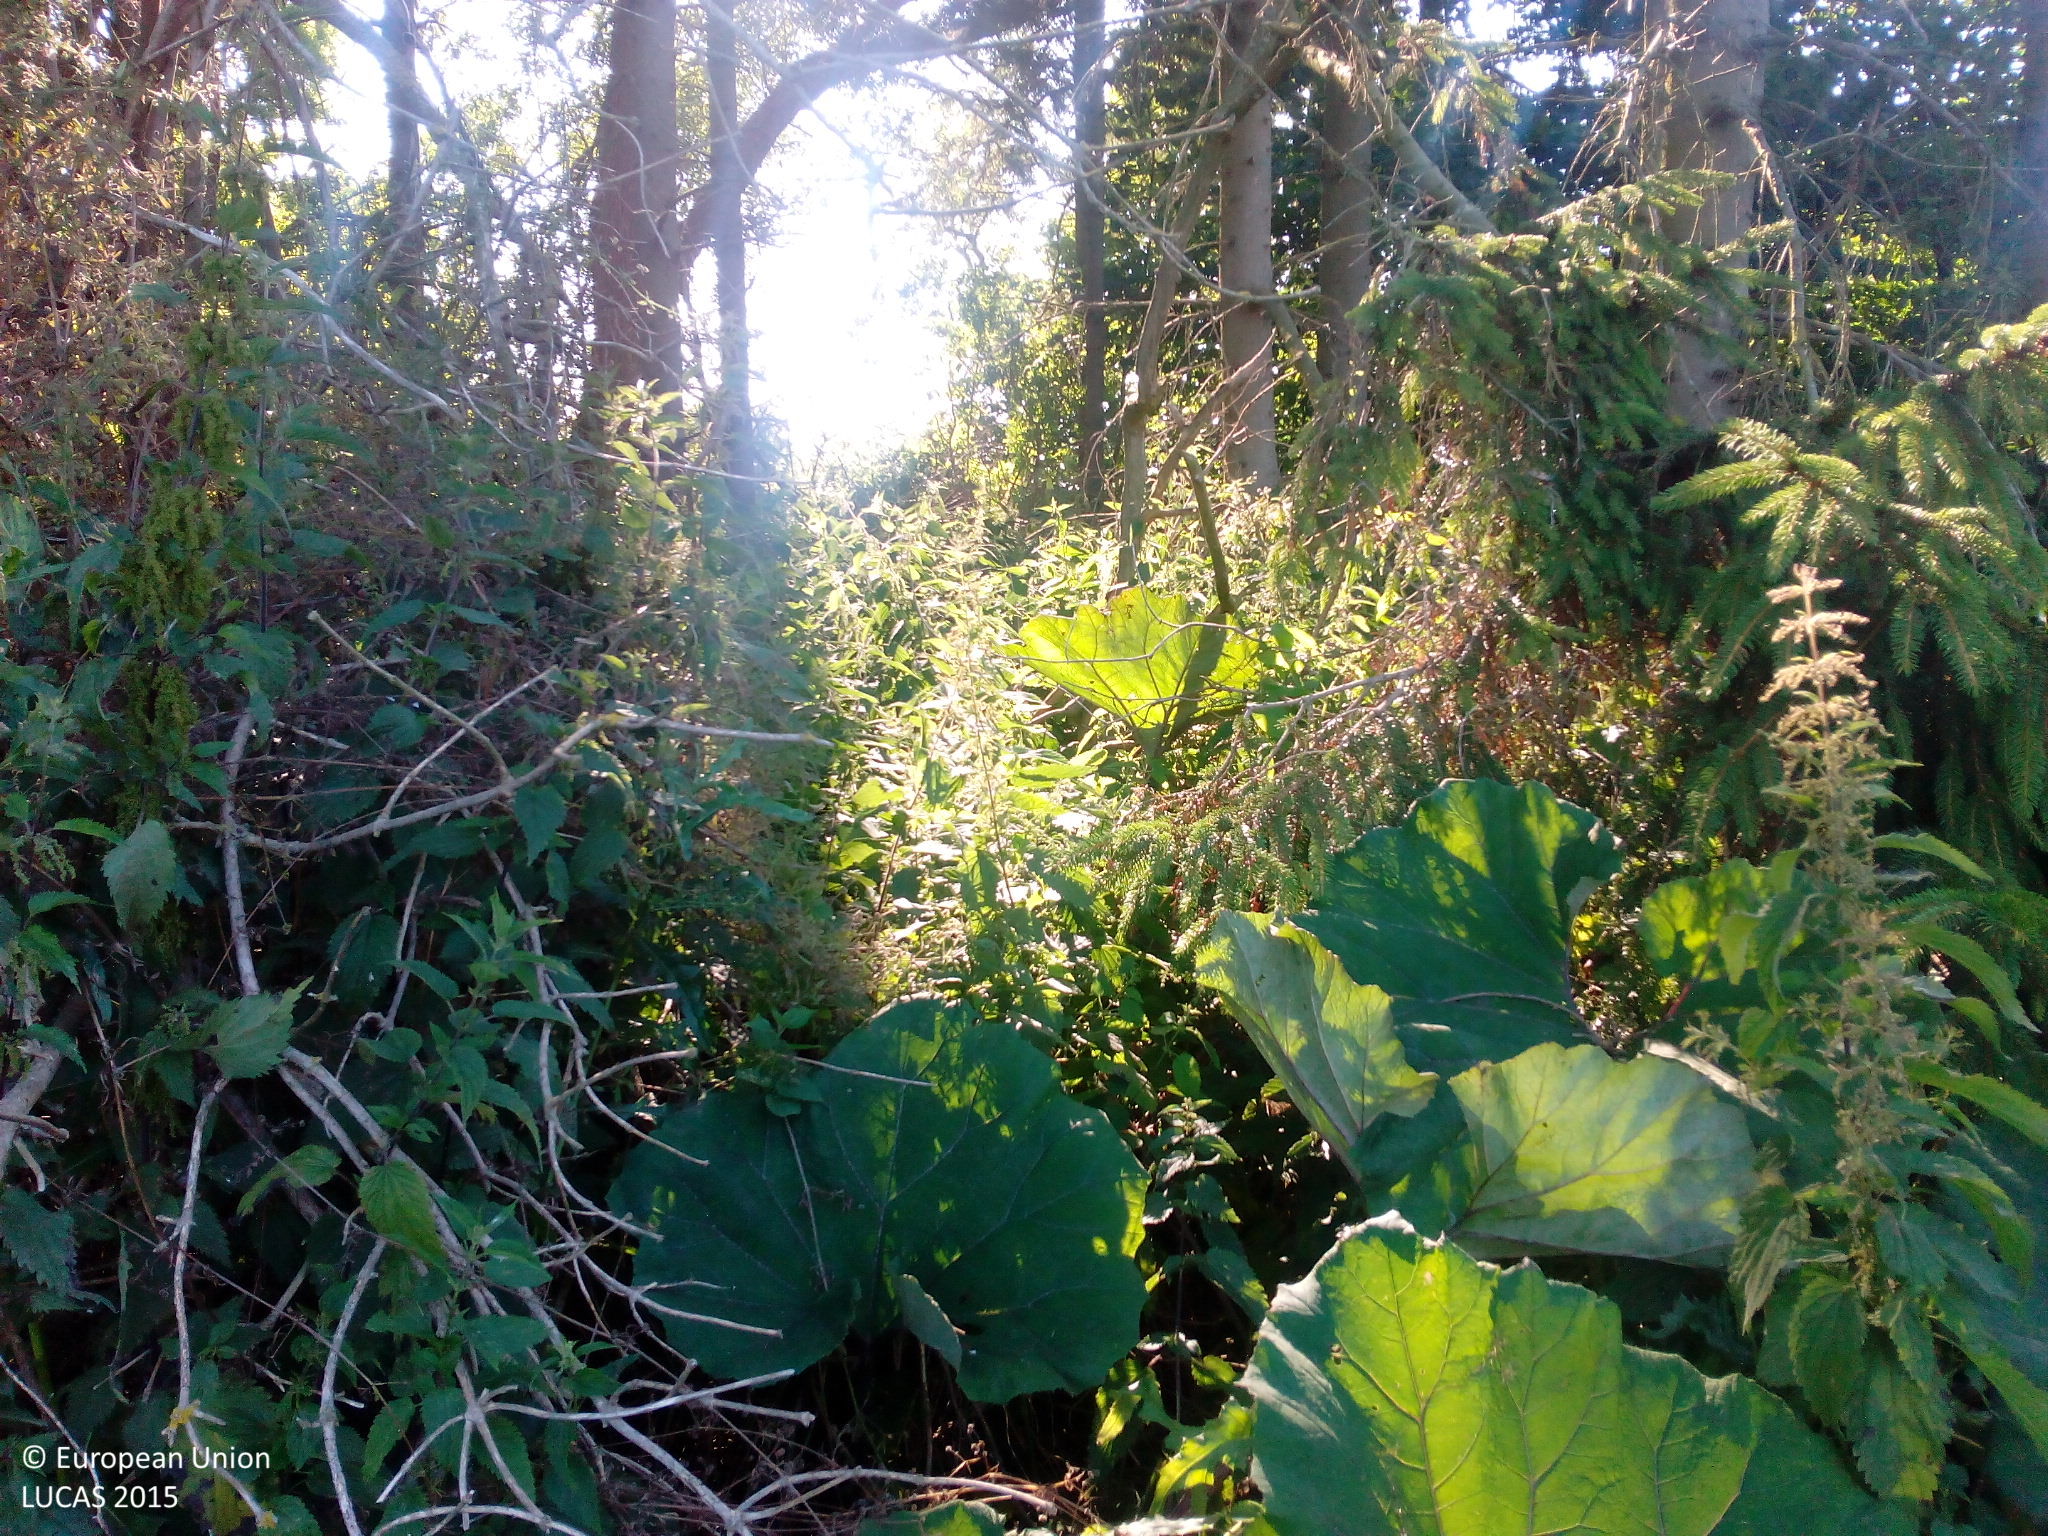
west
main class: Woodland
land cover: Spruce dominated coniferous woodland
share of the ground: > 75 %
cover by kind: coniferous forest trees 80 %, broadleaved forest trees 20 %
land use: Semi-natural and natural areas not in use
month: August
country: DK
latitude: 55.6358
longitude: 11.7935
